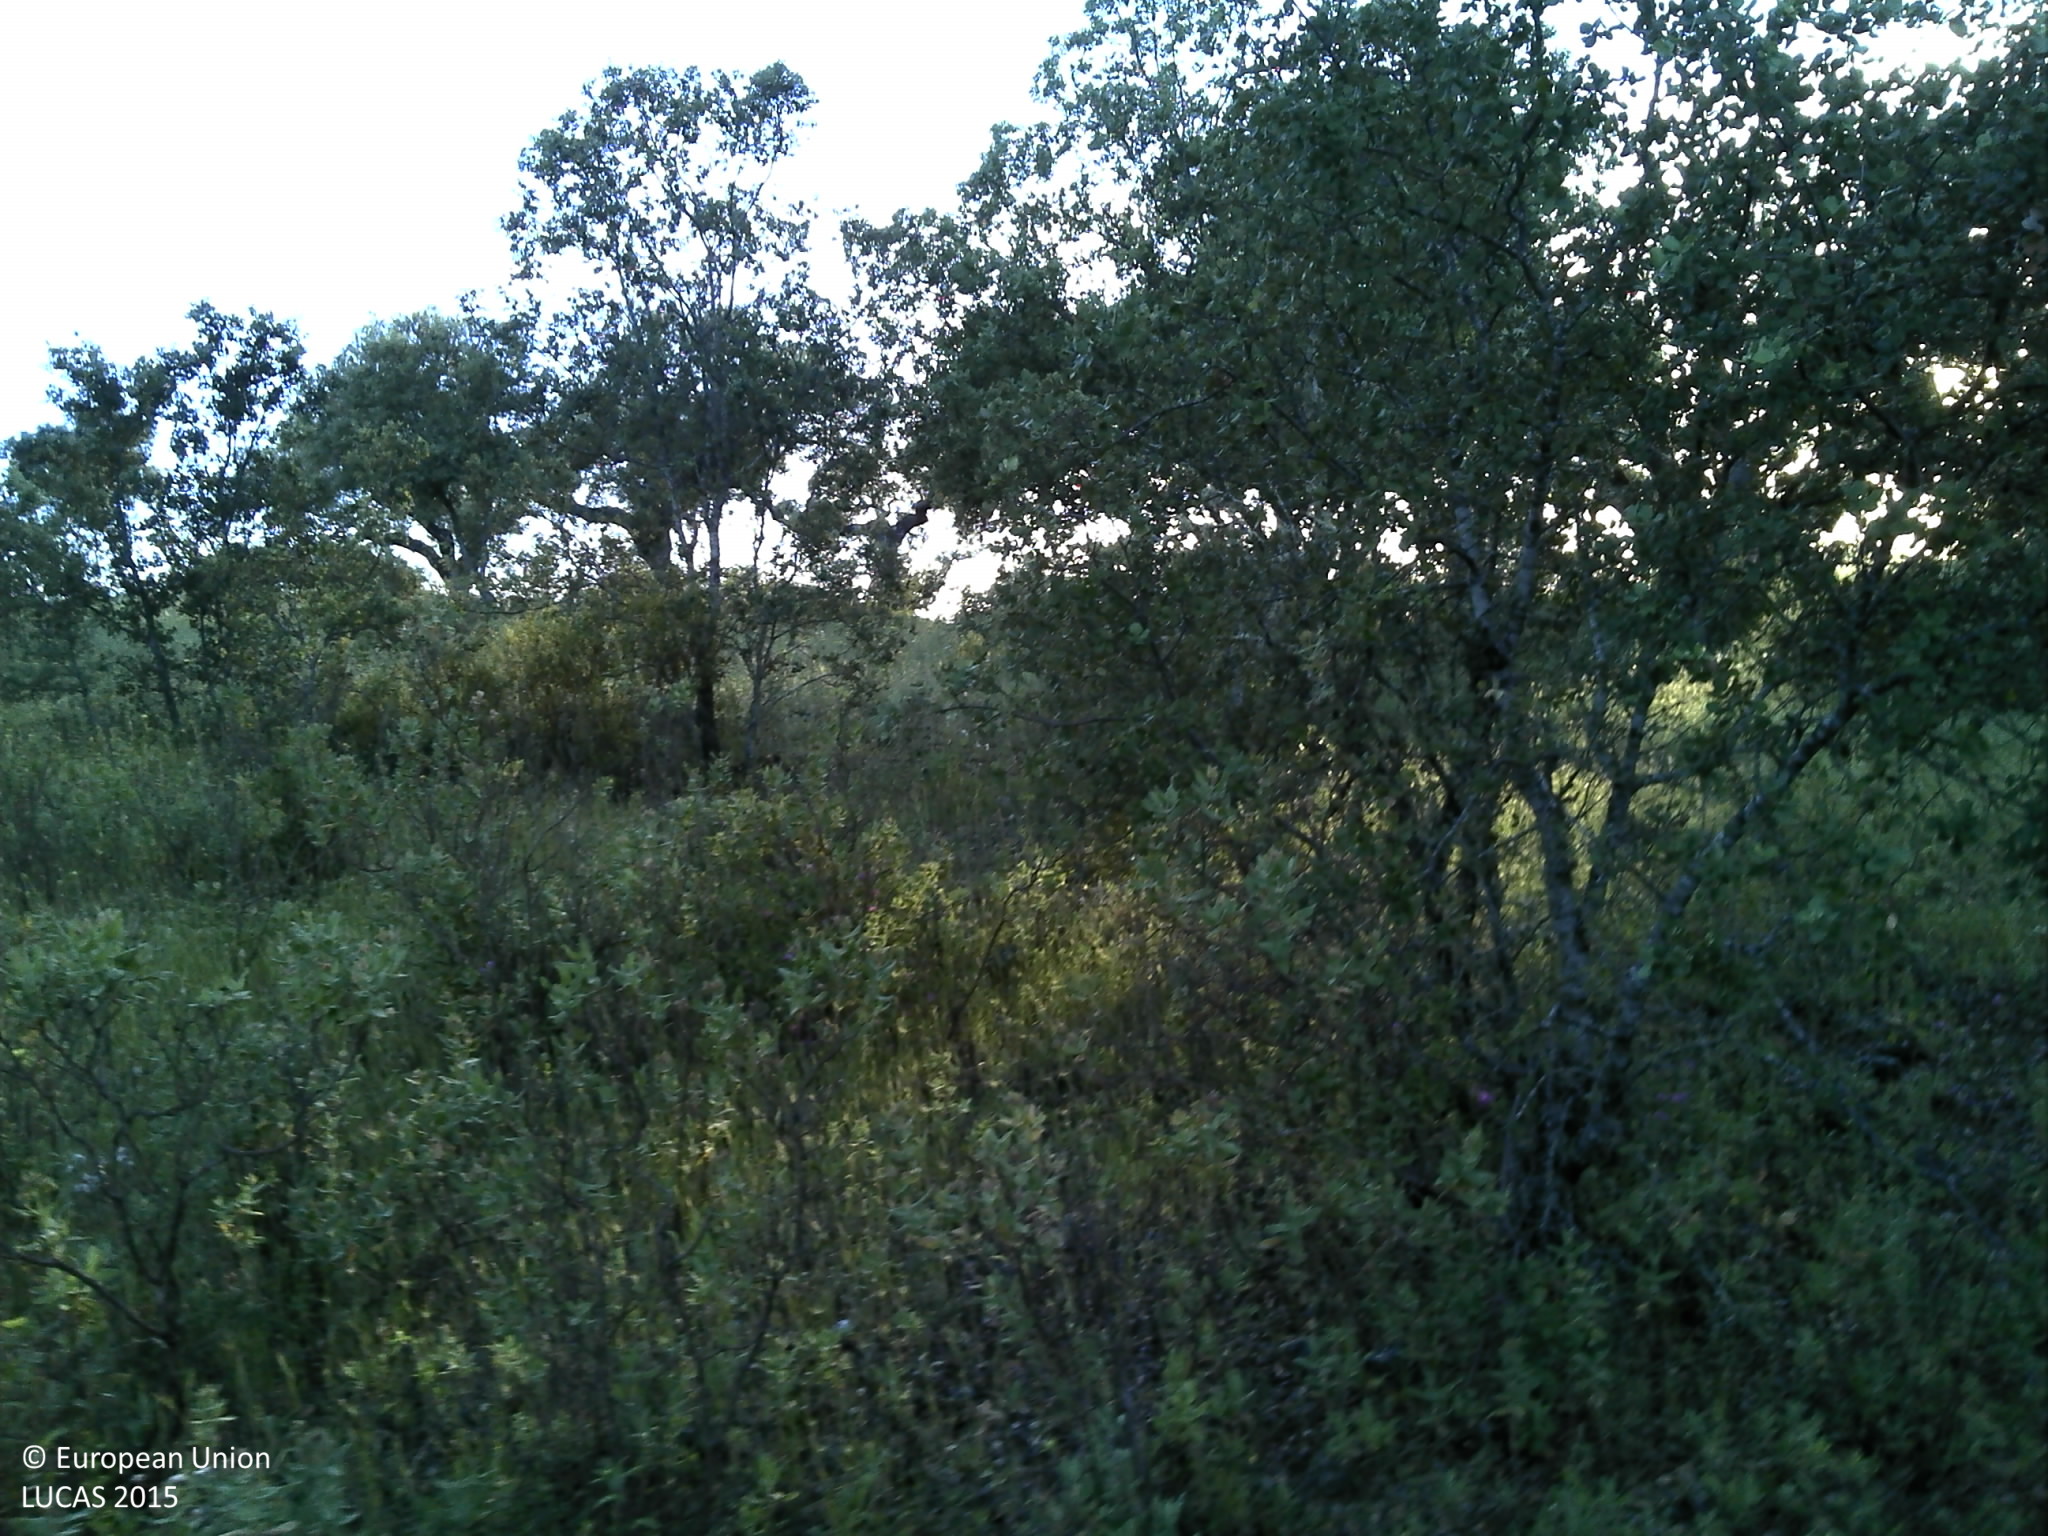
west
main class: Woodland
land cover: Broadleaved woodland
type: broadleaved evergreen forest
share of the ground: 25 - 50 %
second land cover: Grassland without tree/shrub cover
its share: 50 - 75 %
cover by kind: herbaceous plants 50 %, broadleaved forest trees 30 %, unconsolidated bare surface 15 %, shrubs 5 %
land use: Forestry
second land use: Agriculture (excluding fallow land and kitchen gardens)
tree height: > 5 m
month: May
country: PT
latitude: 39.1063
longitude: -7.8925
